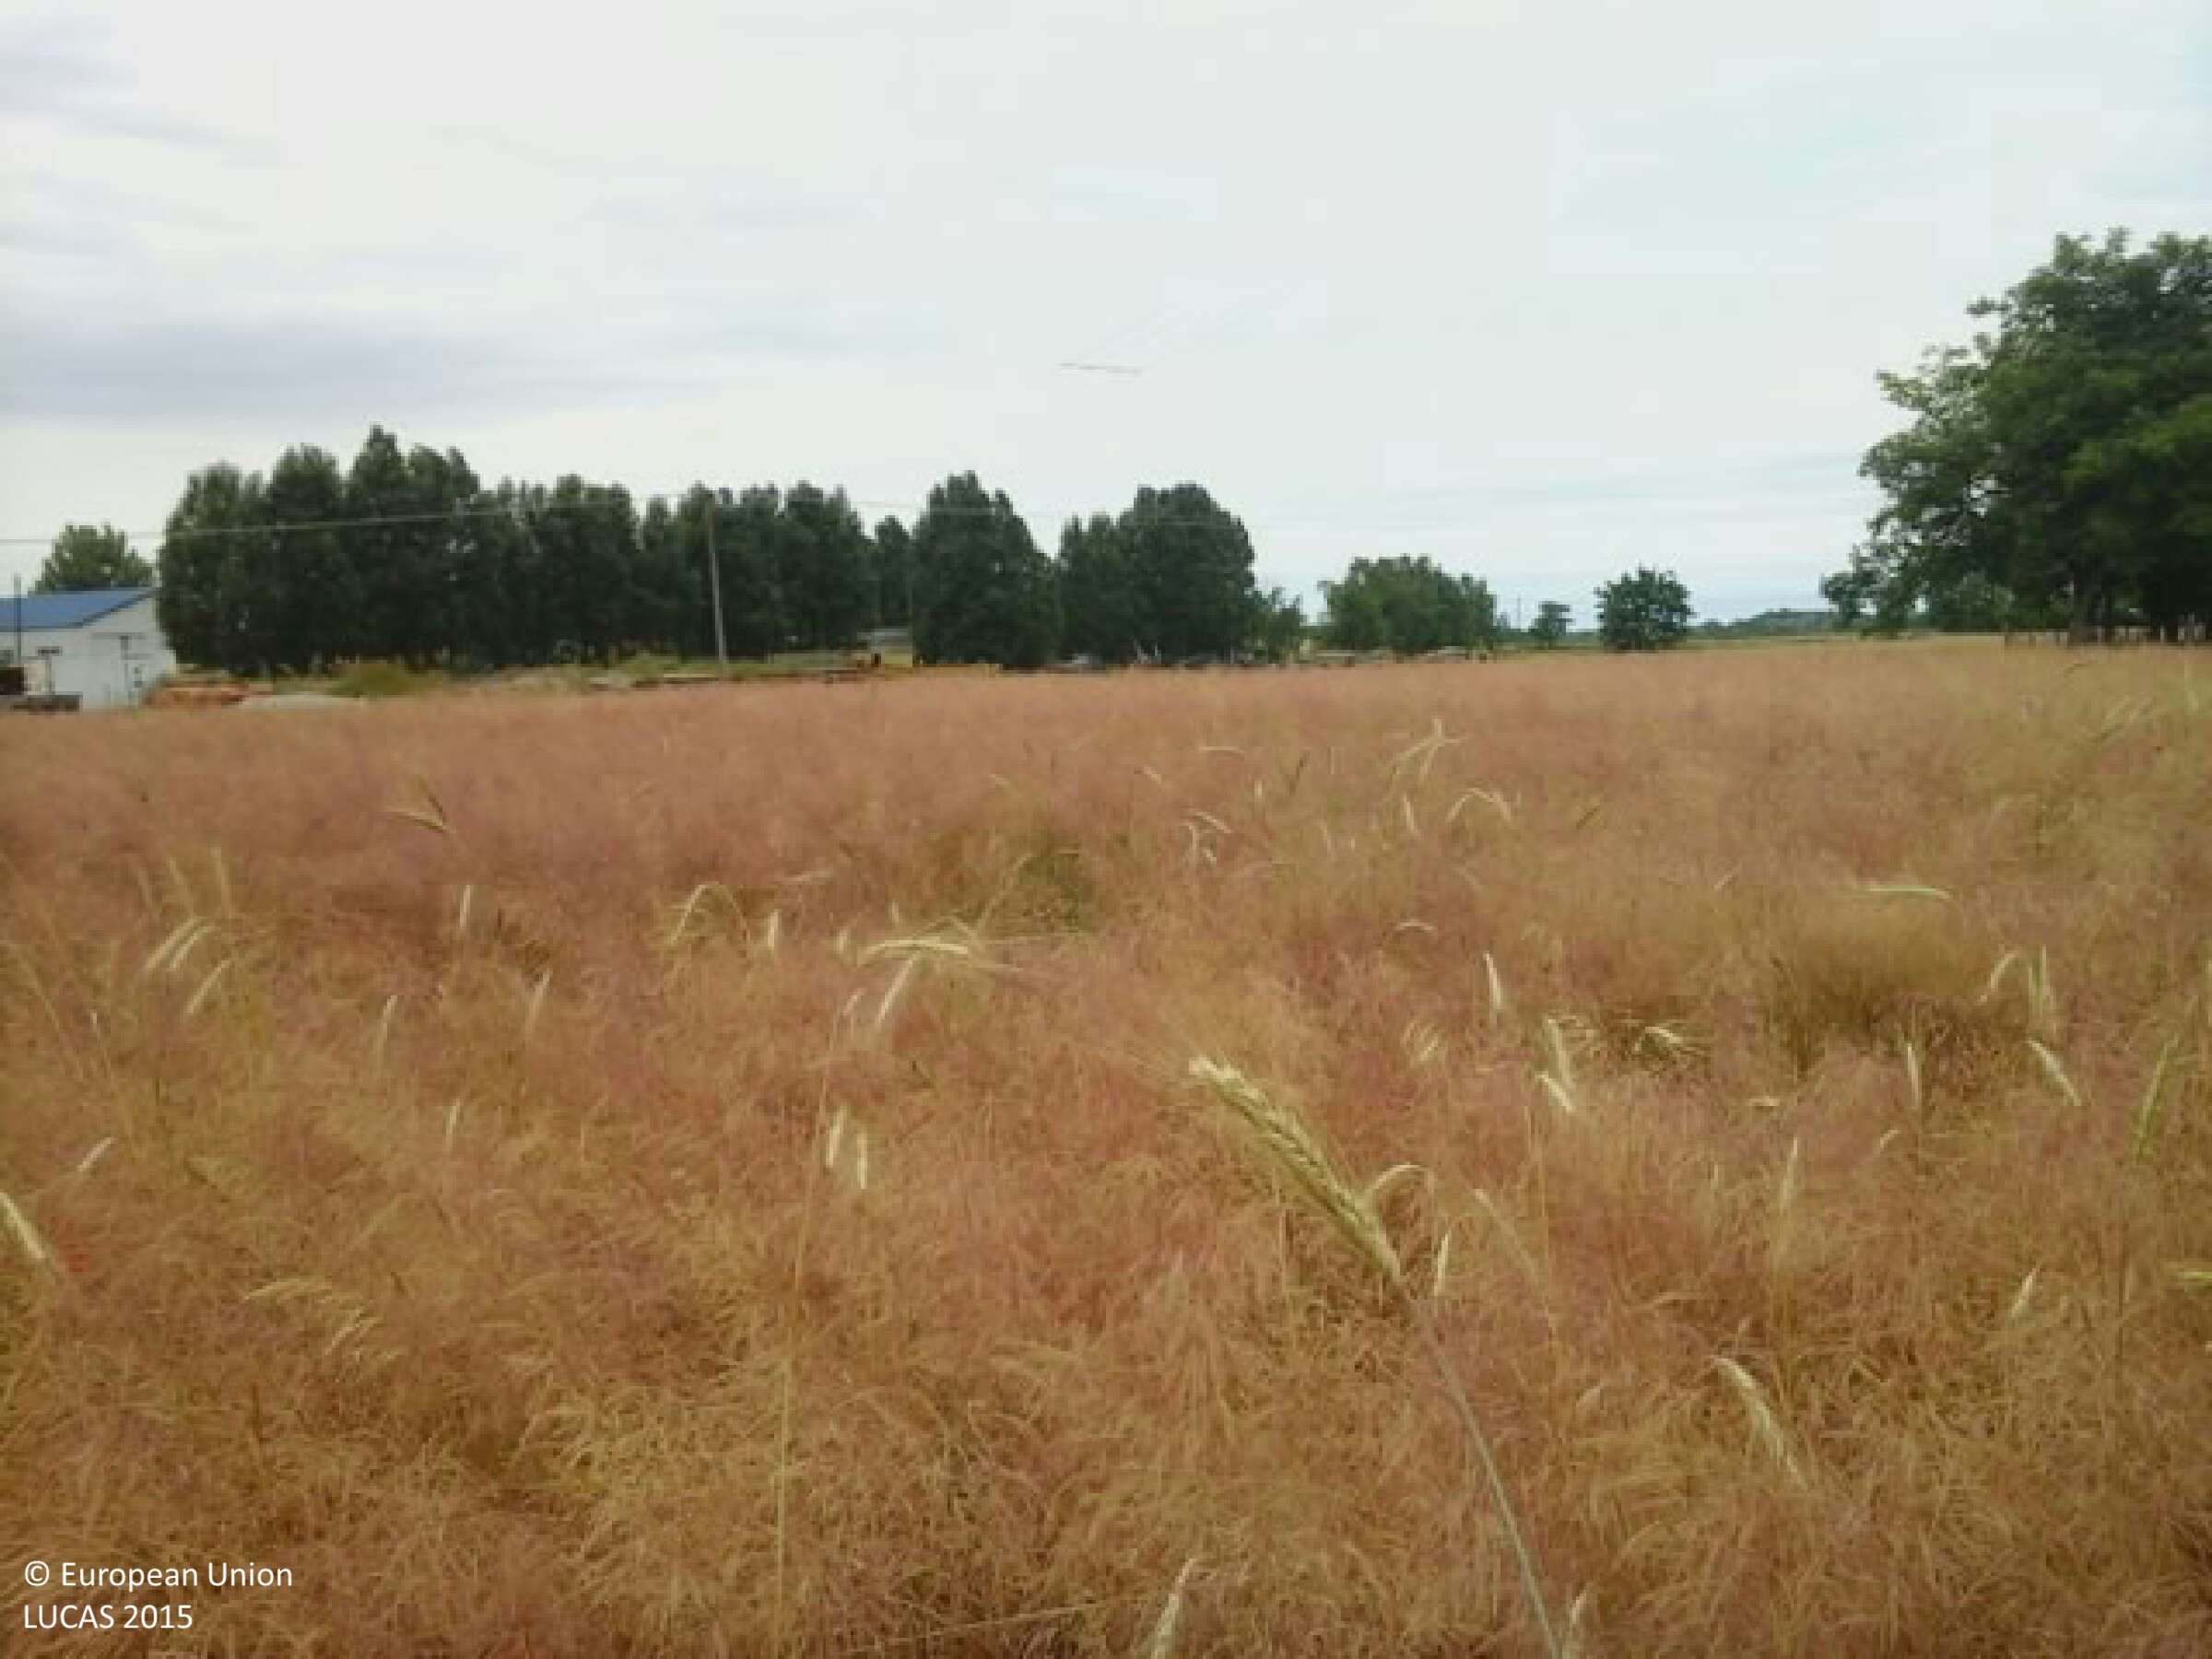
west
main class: Grassland
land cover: Grassland without tree/shrub cover
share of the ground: > 75 %
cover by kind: herbaceous plants 100 %
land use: Agriculture (excluding fallow land and kitchen gardens)
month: June
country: HU
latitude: 46.7535
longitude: 19.5889
